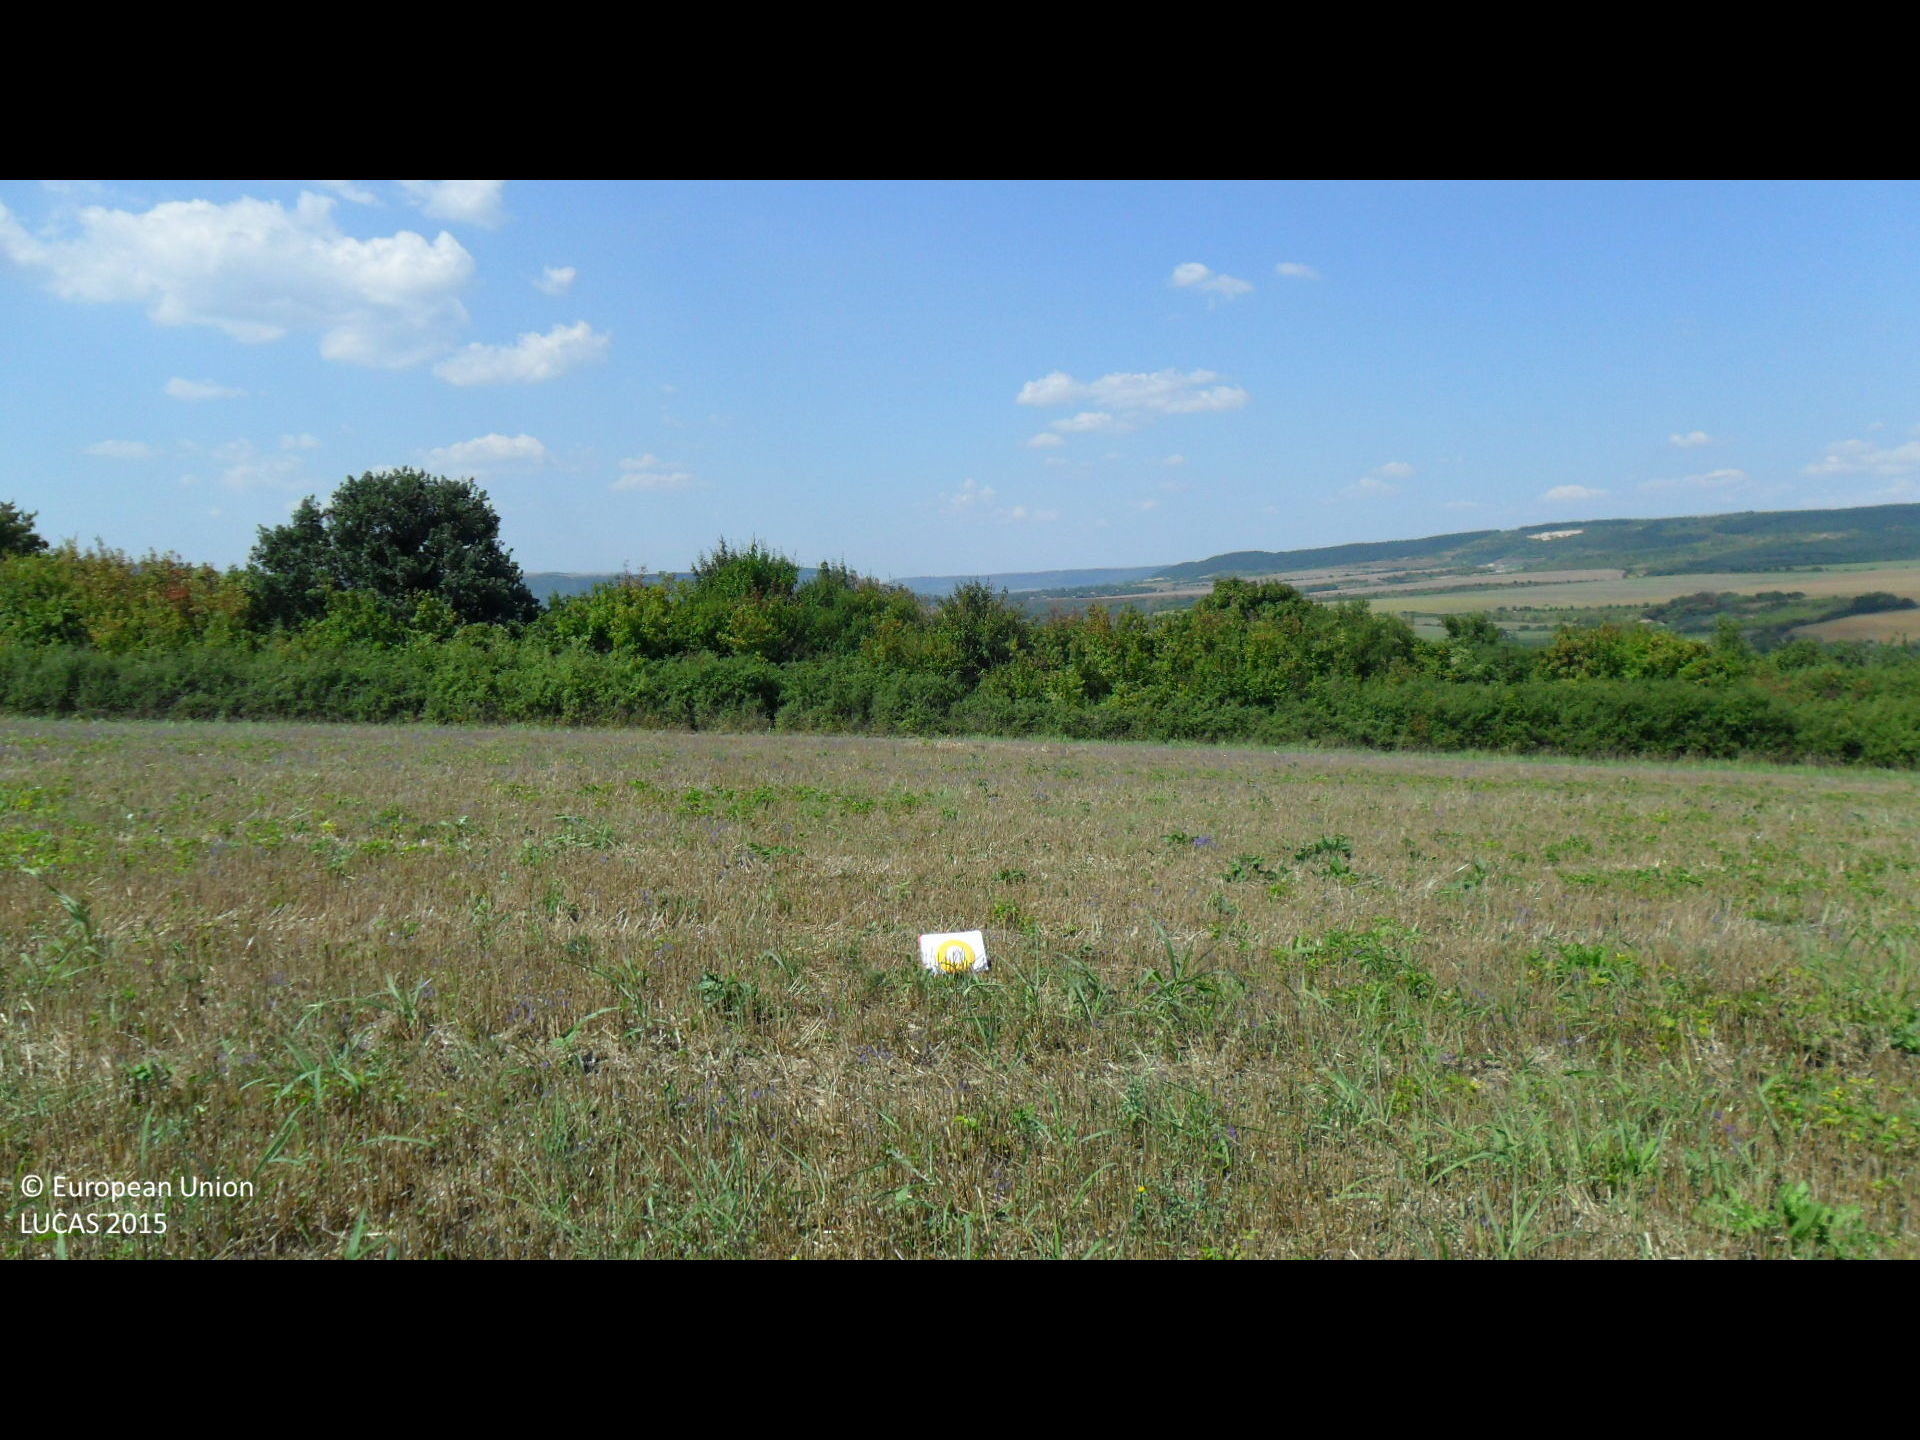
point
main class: Cropland
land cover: Barley
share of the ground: 50 - 75 %
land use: Agriculture (excluding fallow land and kitchen gardens)
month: August
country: BG
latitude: 43.4513
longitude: 26.3253
